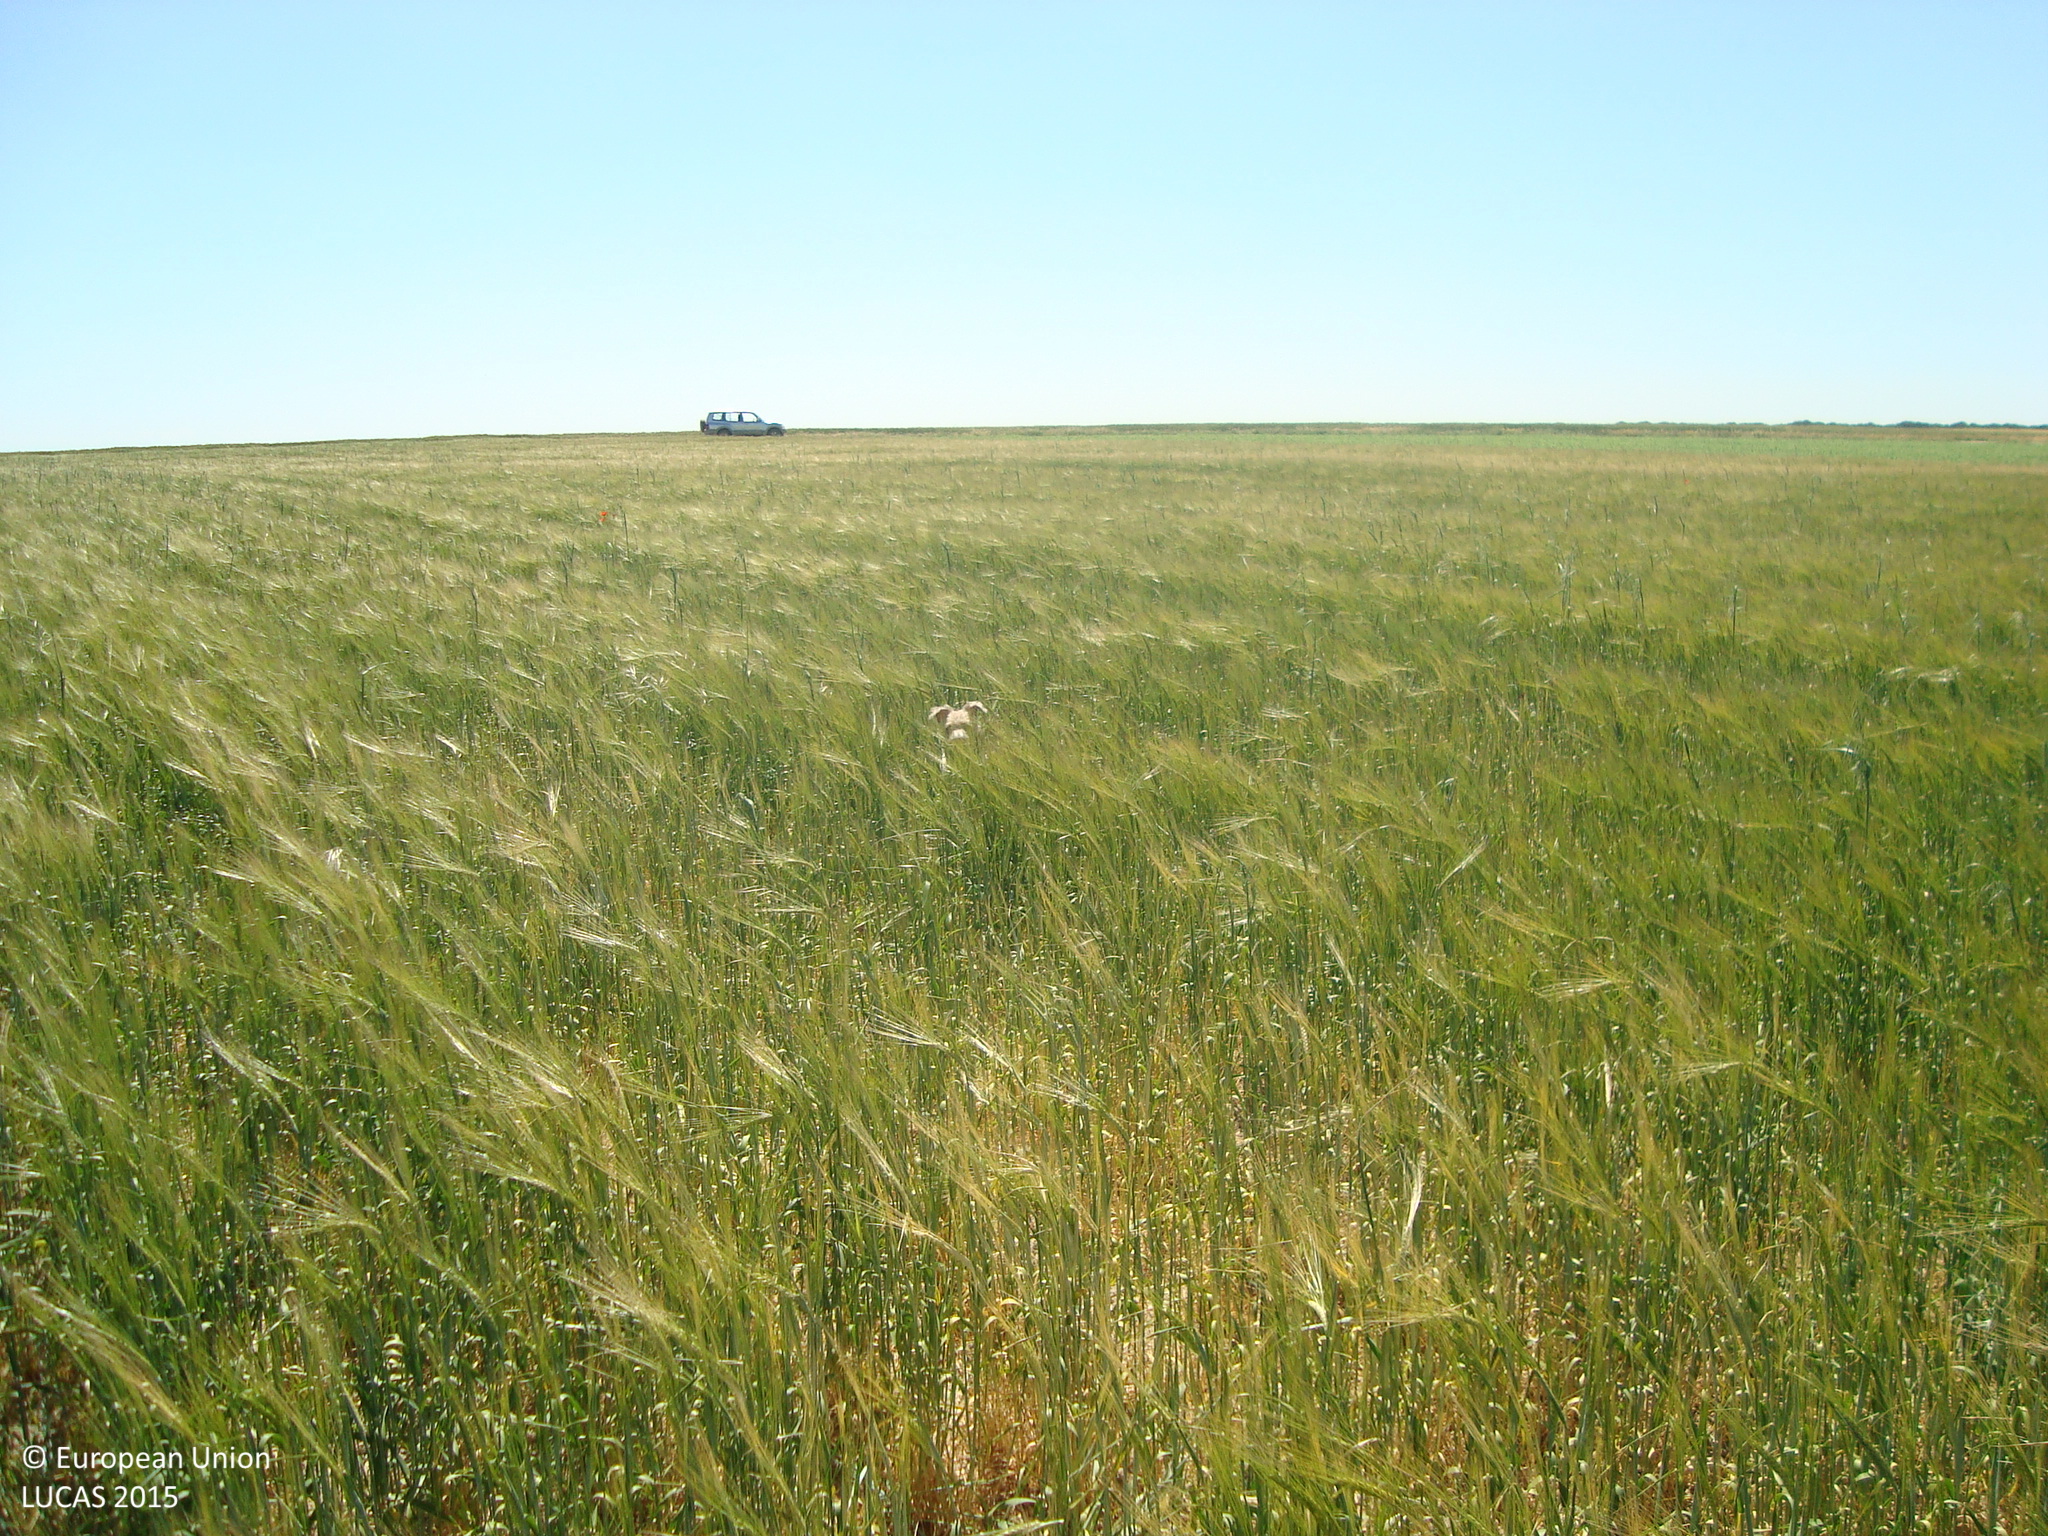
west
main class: Cropland
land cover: Mixed cereals for fodder
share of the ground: > 75 %
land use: Agriculture (excluding fallow land and kitchen gardens)
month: May
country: ES
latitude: 41.4995
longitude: -4.0845
